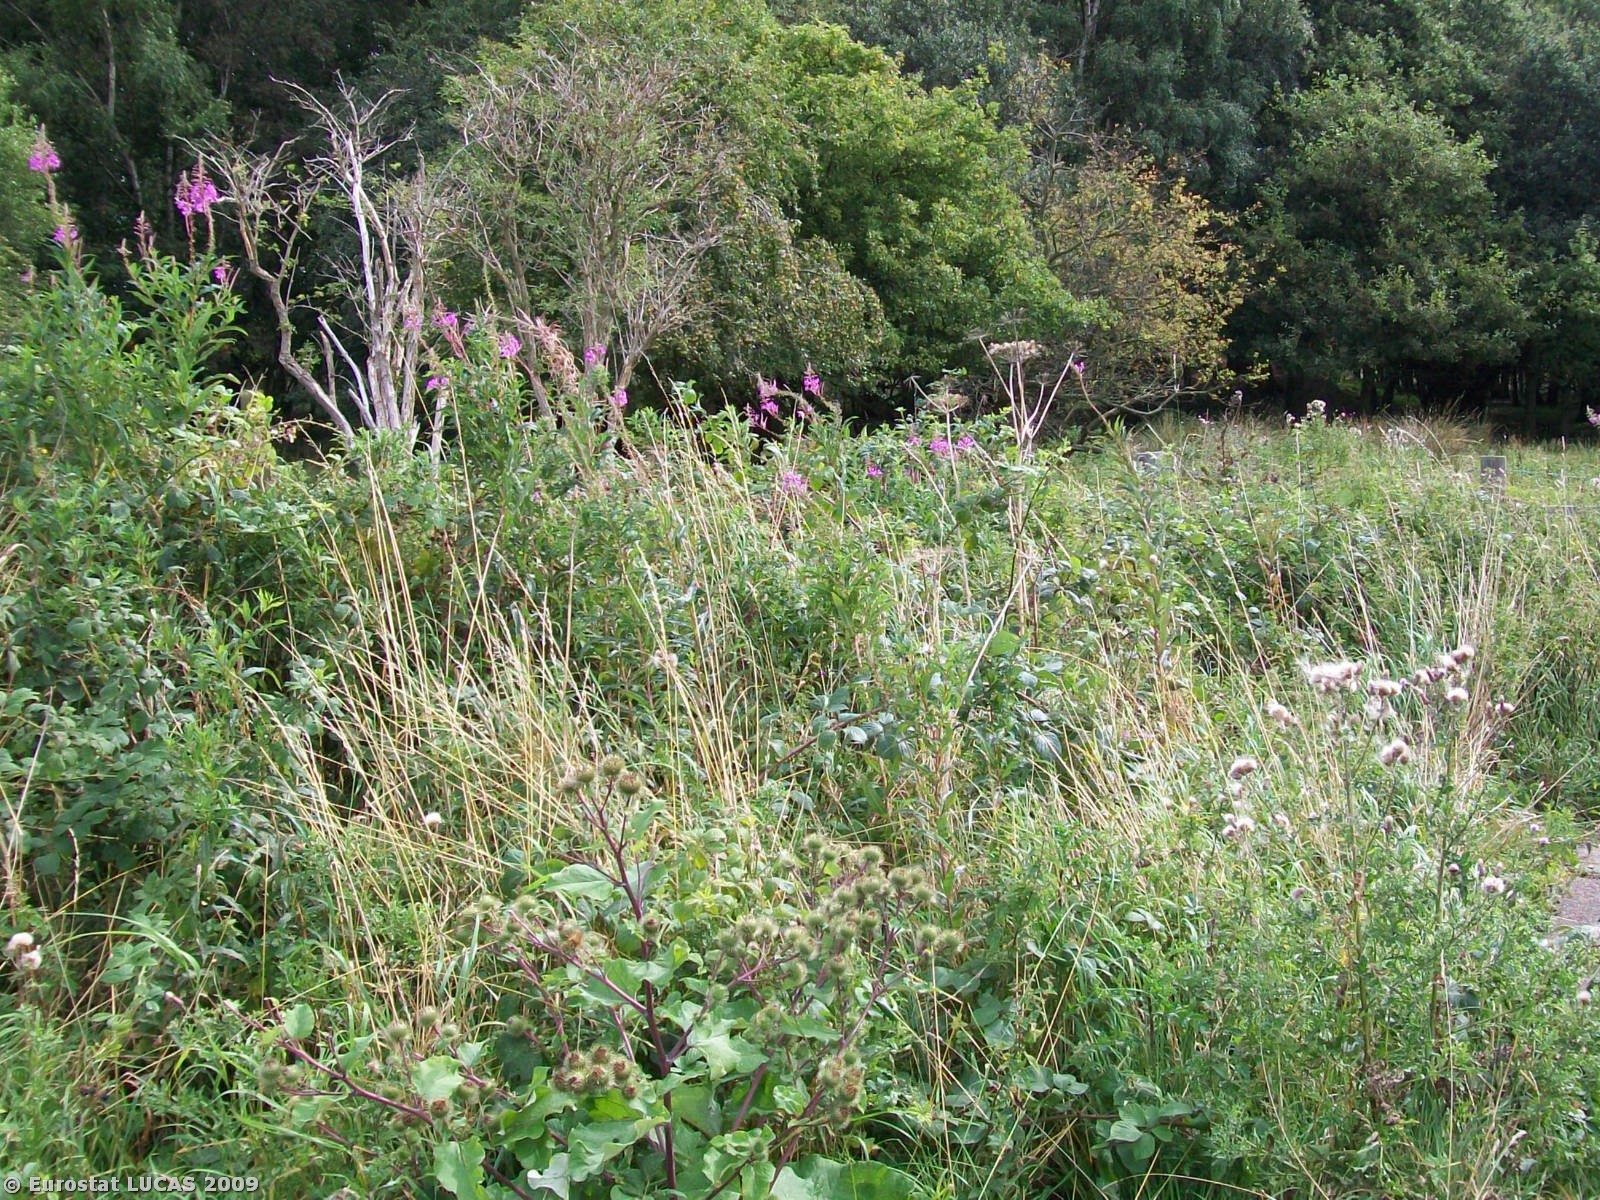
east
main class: Cropland
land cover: Sugar beet
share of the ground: > 75 %
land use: Agriculture (excluding fallow land and kitchen gardens)
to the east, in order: Sugar beet; Grass margins; Ditches and canals; Grass margins; Sugar beet
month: August
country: GB
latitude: 53.8225
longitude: -1.0264
